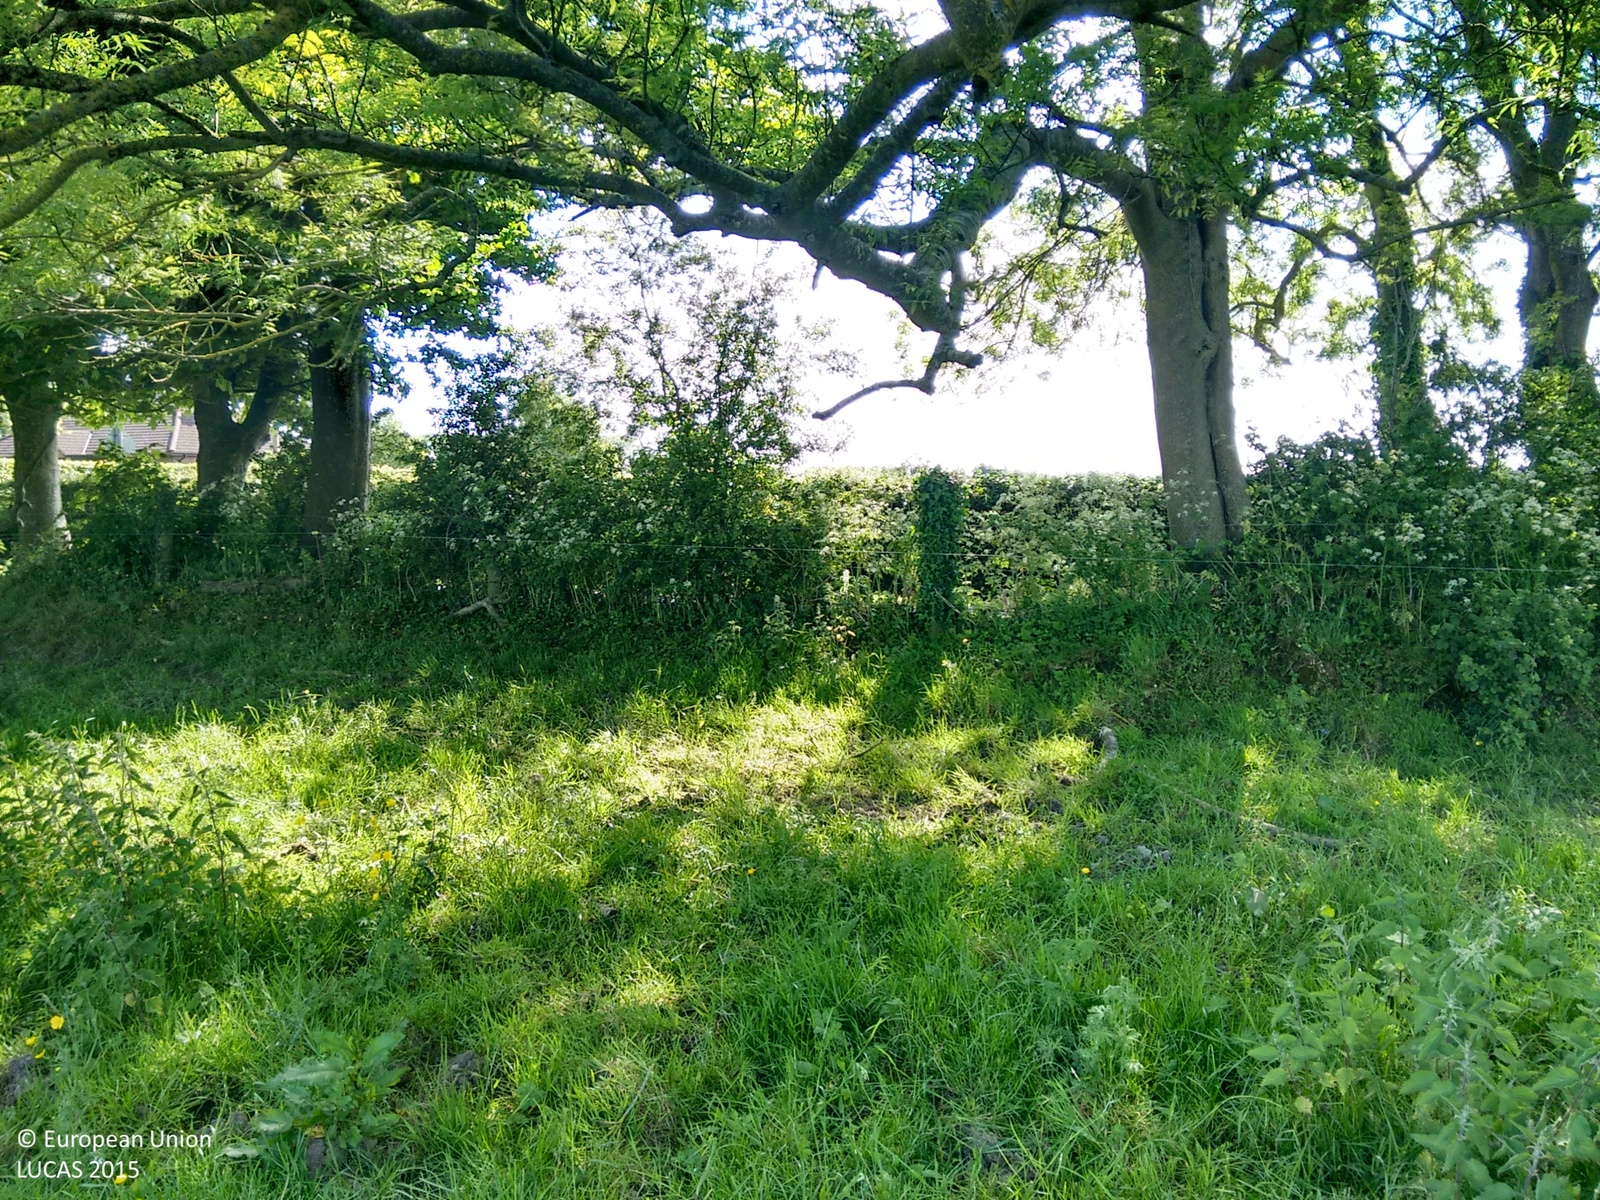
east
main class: Grassland
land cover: Grassland without tree/shrub cover
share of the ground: > 75 %
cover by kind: herbaceous plants 90 %, unconsolidated bare surface 10 %
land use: Agriculture (excluding fallow land and kitchen gardens)
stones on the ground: < 10 %
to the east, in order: Grassland without tree/shrub cover; Fences; Broadleaved woodland; Grassland without tree/shrub cover; Managed hedges; Grassland without tree/shrub cover
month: June
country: IE
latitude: 53.4363
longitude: -6.4889
